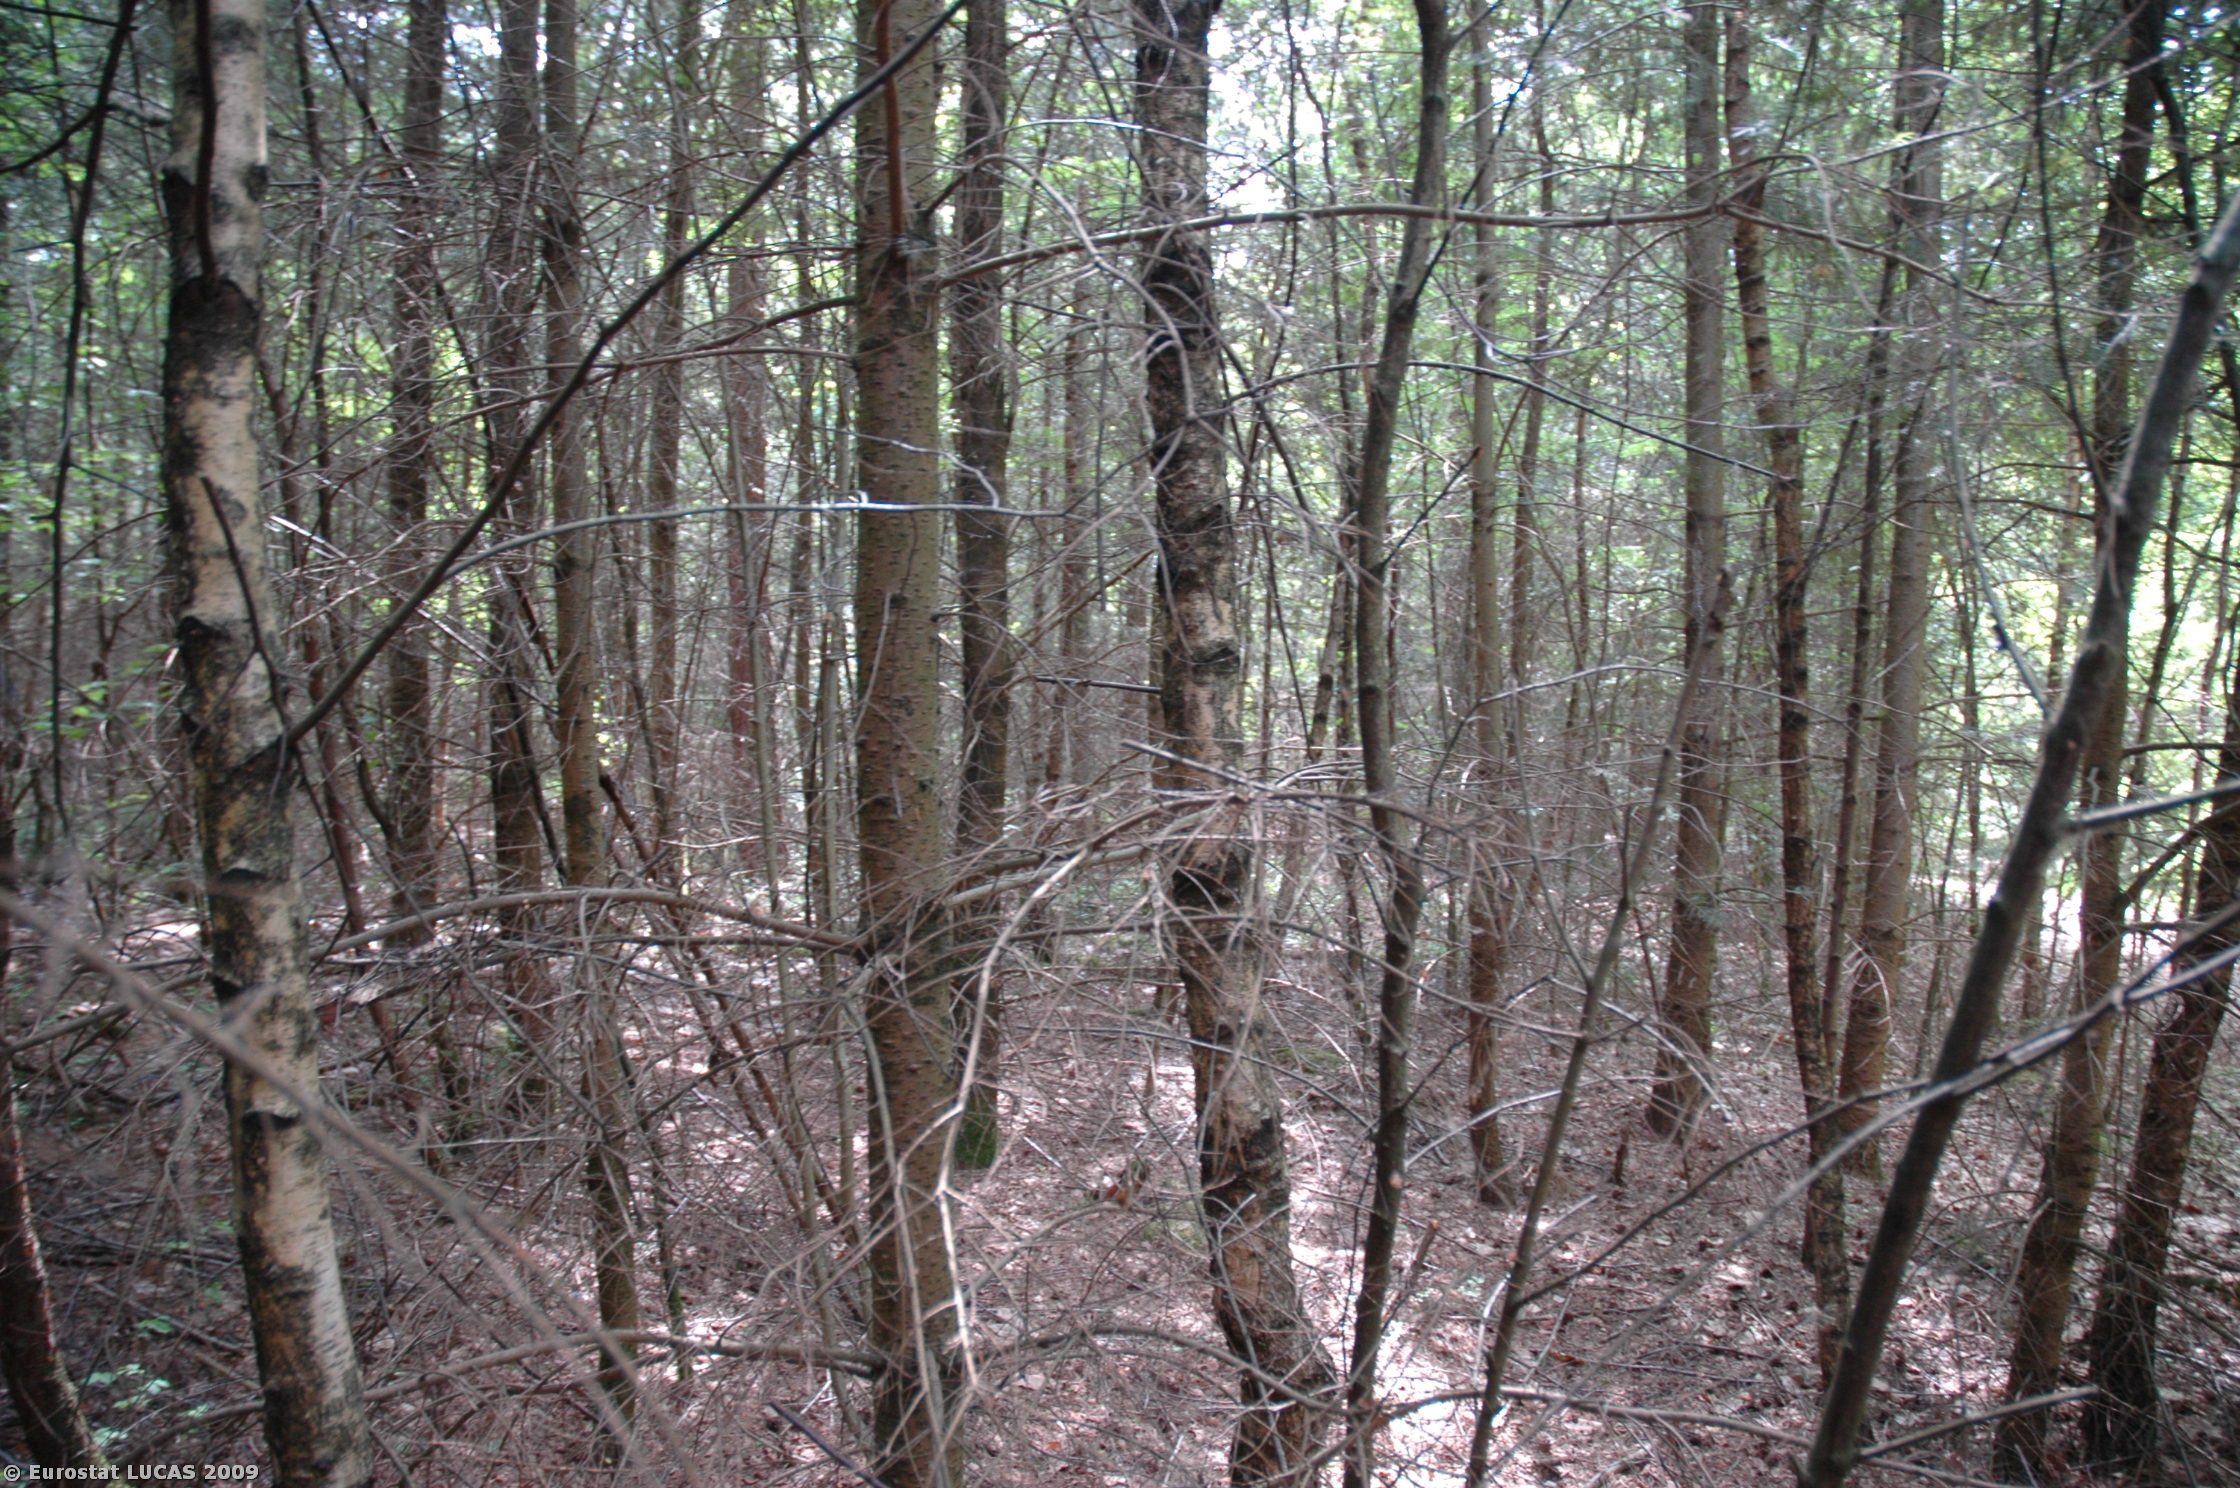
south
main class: Woodland
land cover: Mixed woodland
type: hemiboreal forest and nemoral coniferous forest and mixed broadleaved-coniferous forest
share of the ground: > 75 %
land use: Amenities, museums, leisure
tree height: > 5 m
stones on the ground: < 10 %
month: May
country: NL
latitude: 52.0881
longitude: 5.3423
